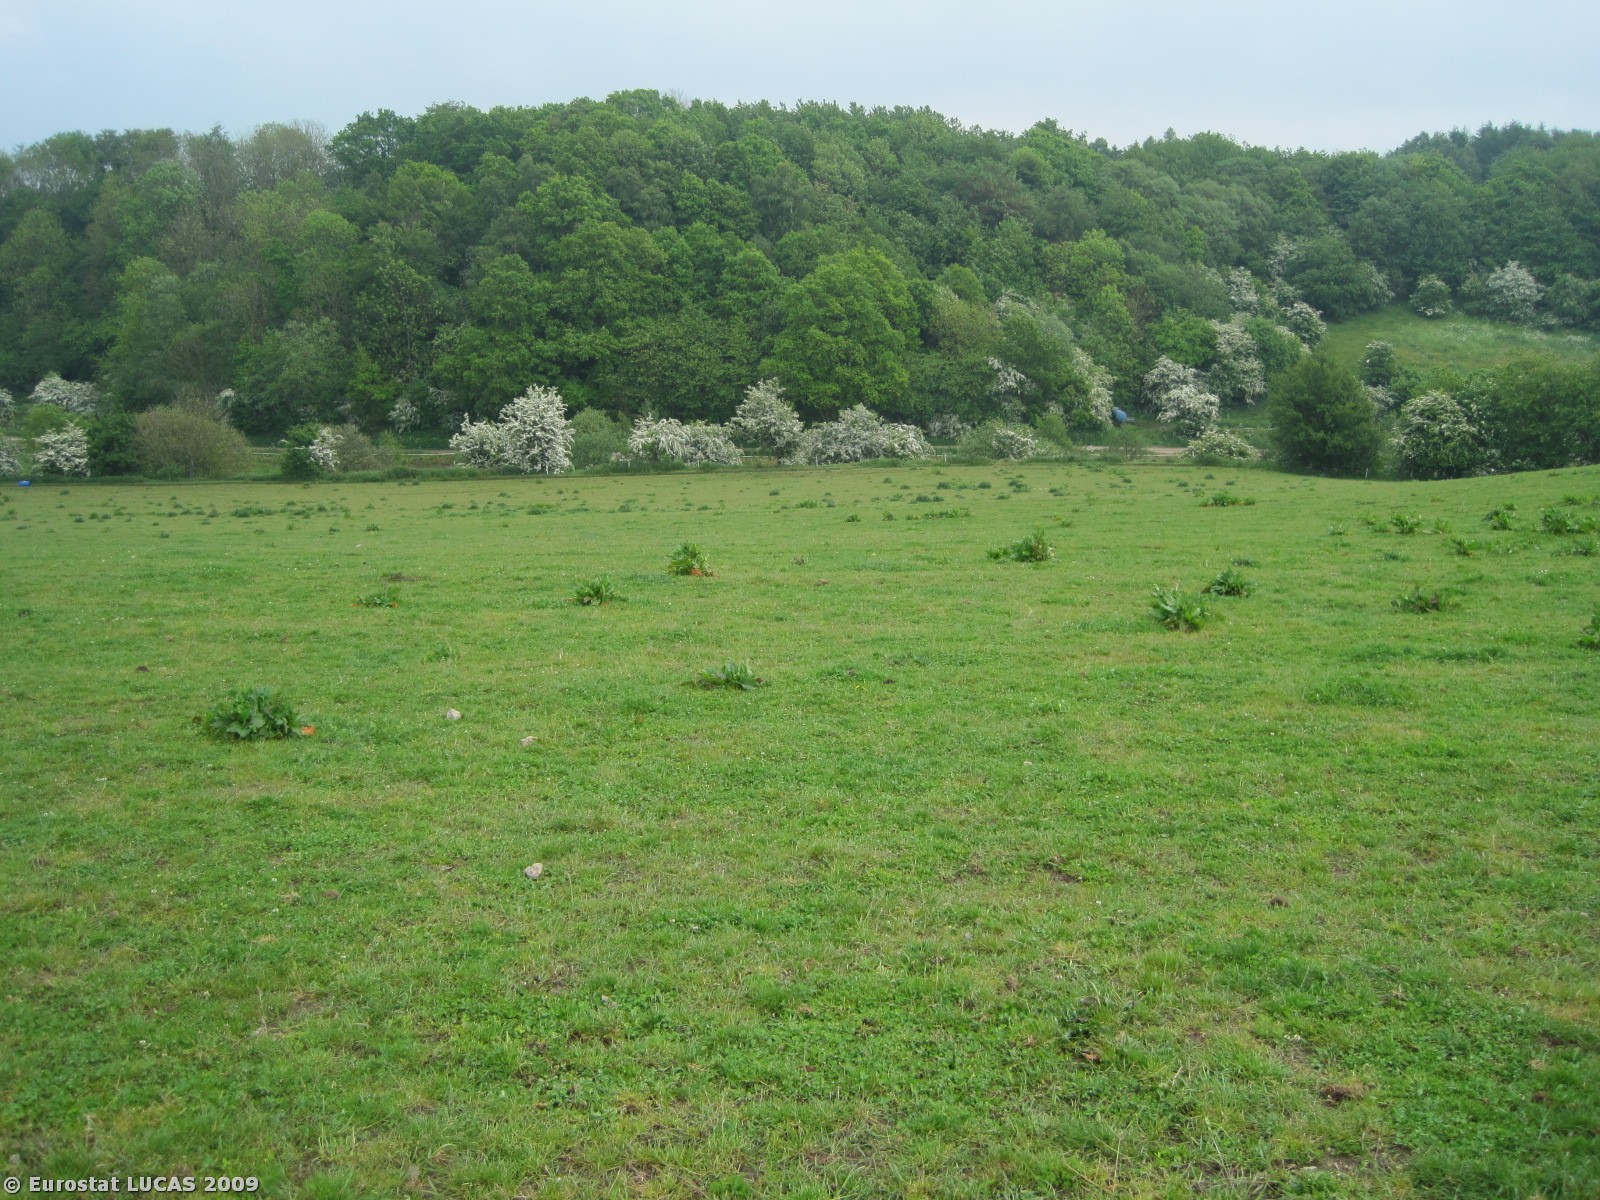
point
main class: Grassland
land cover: Grassland without tree/shrub cover
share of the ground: > 75 %
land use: Agriculture (excluding fallow land and kitchen gardens)
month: May
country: DK
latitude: 56.4033
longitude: 9.8220
